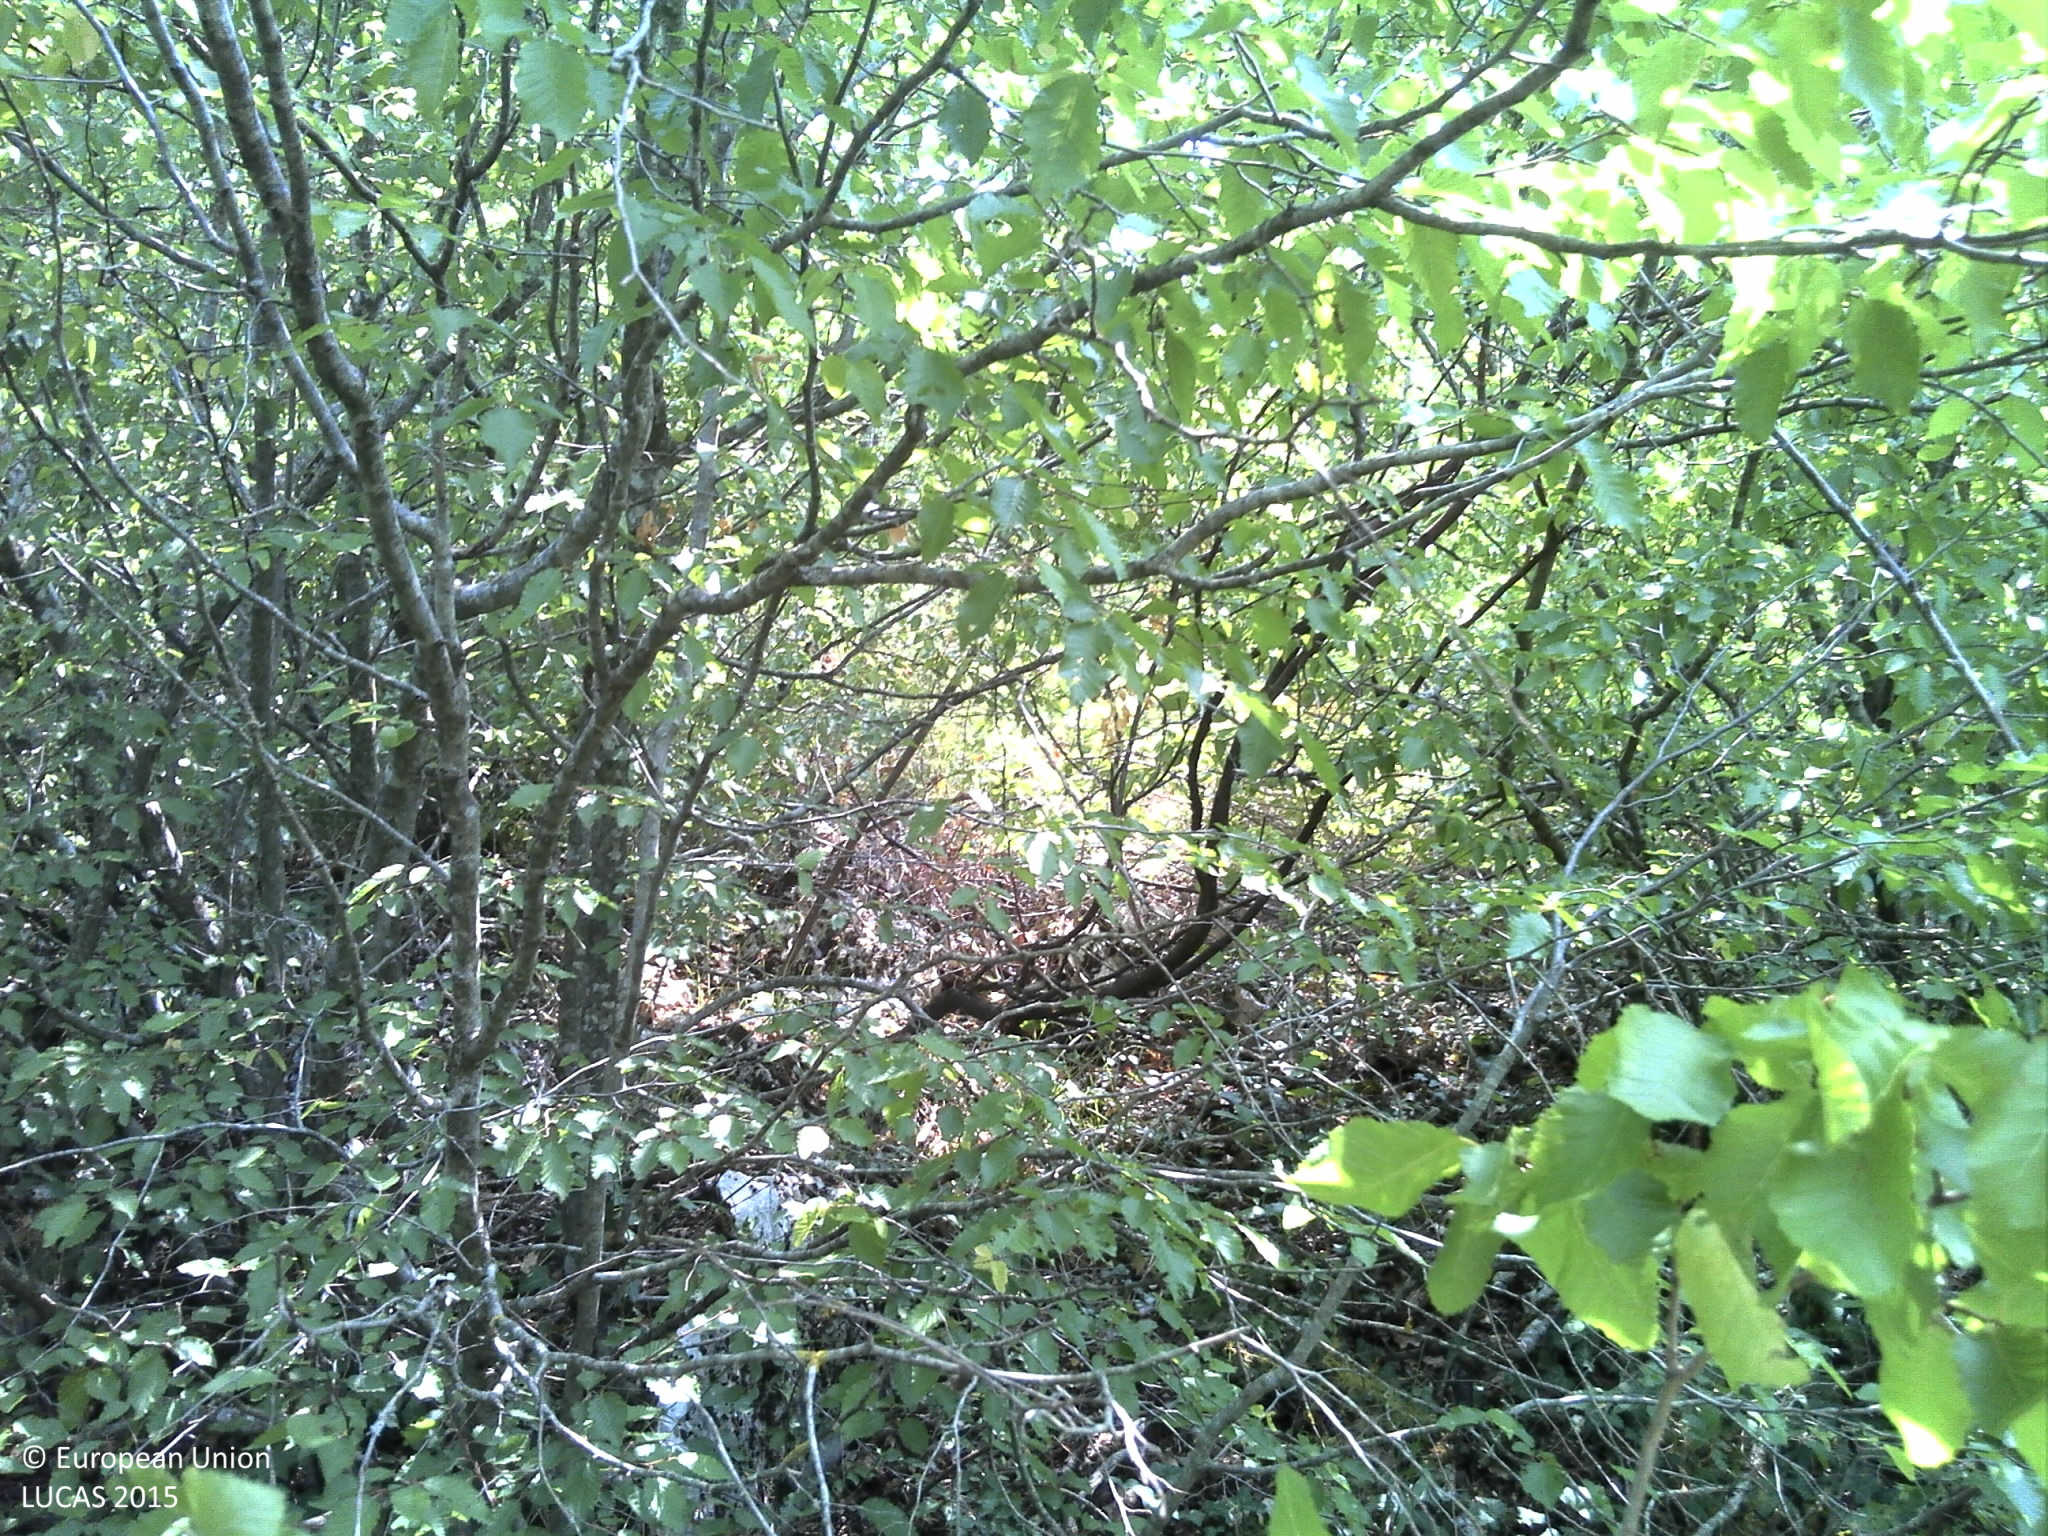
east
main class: Woodland
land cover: Broadleaved woodland
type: thermophilous deciduous forest
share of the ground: 50 - 75 %
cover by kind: broadleaved forest trees 65 %, shrubs 25 %, herbaceous plants 5 %, consolidated bare surface 5 %
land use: Semi-natural and natural areas not in use
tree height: > 5 m
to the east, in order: Broadleaved woodland; Dry stone walls; Shrubland with sparse tree cover; Broadleaved woodland
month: July
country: HR
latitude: 43.5033
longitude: 16.9301
